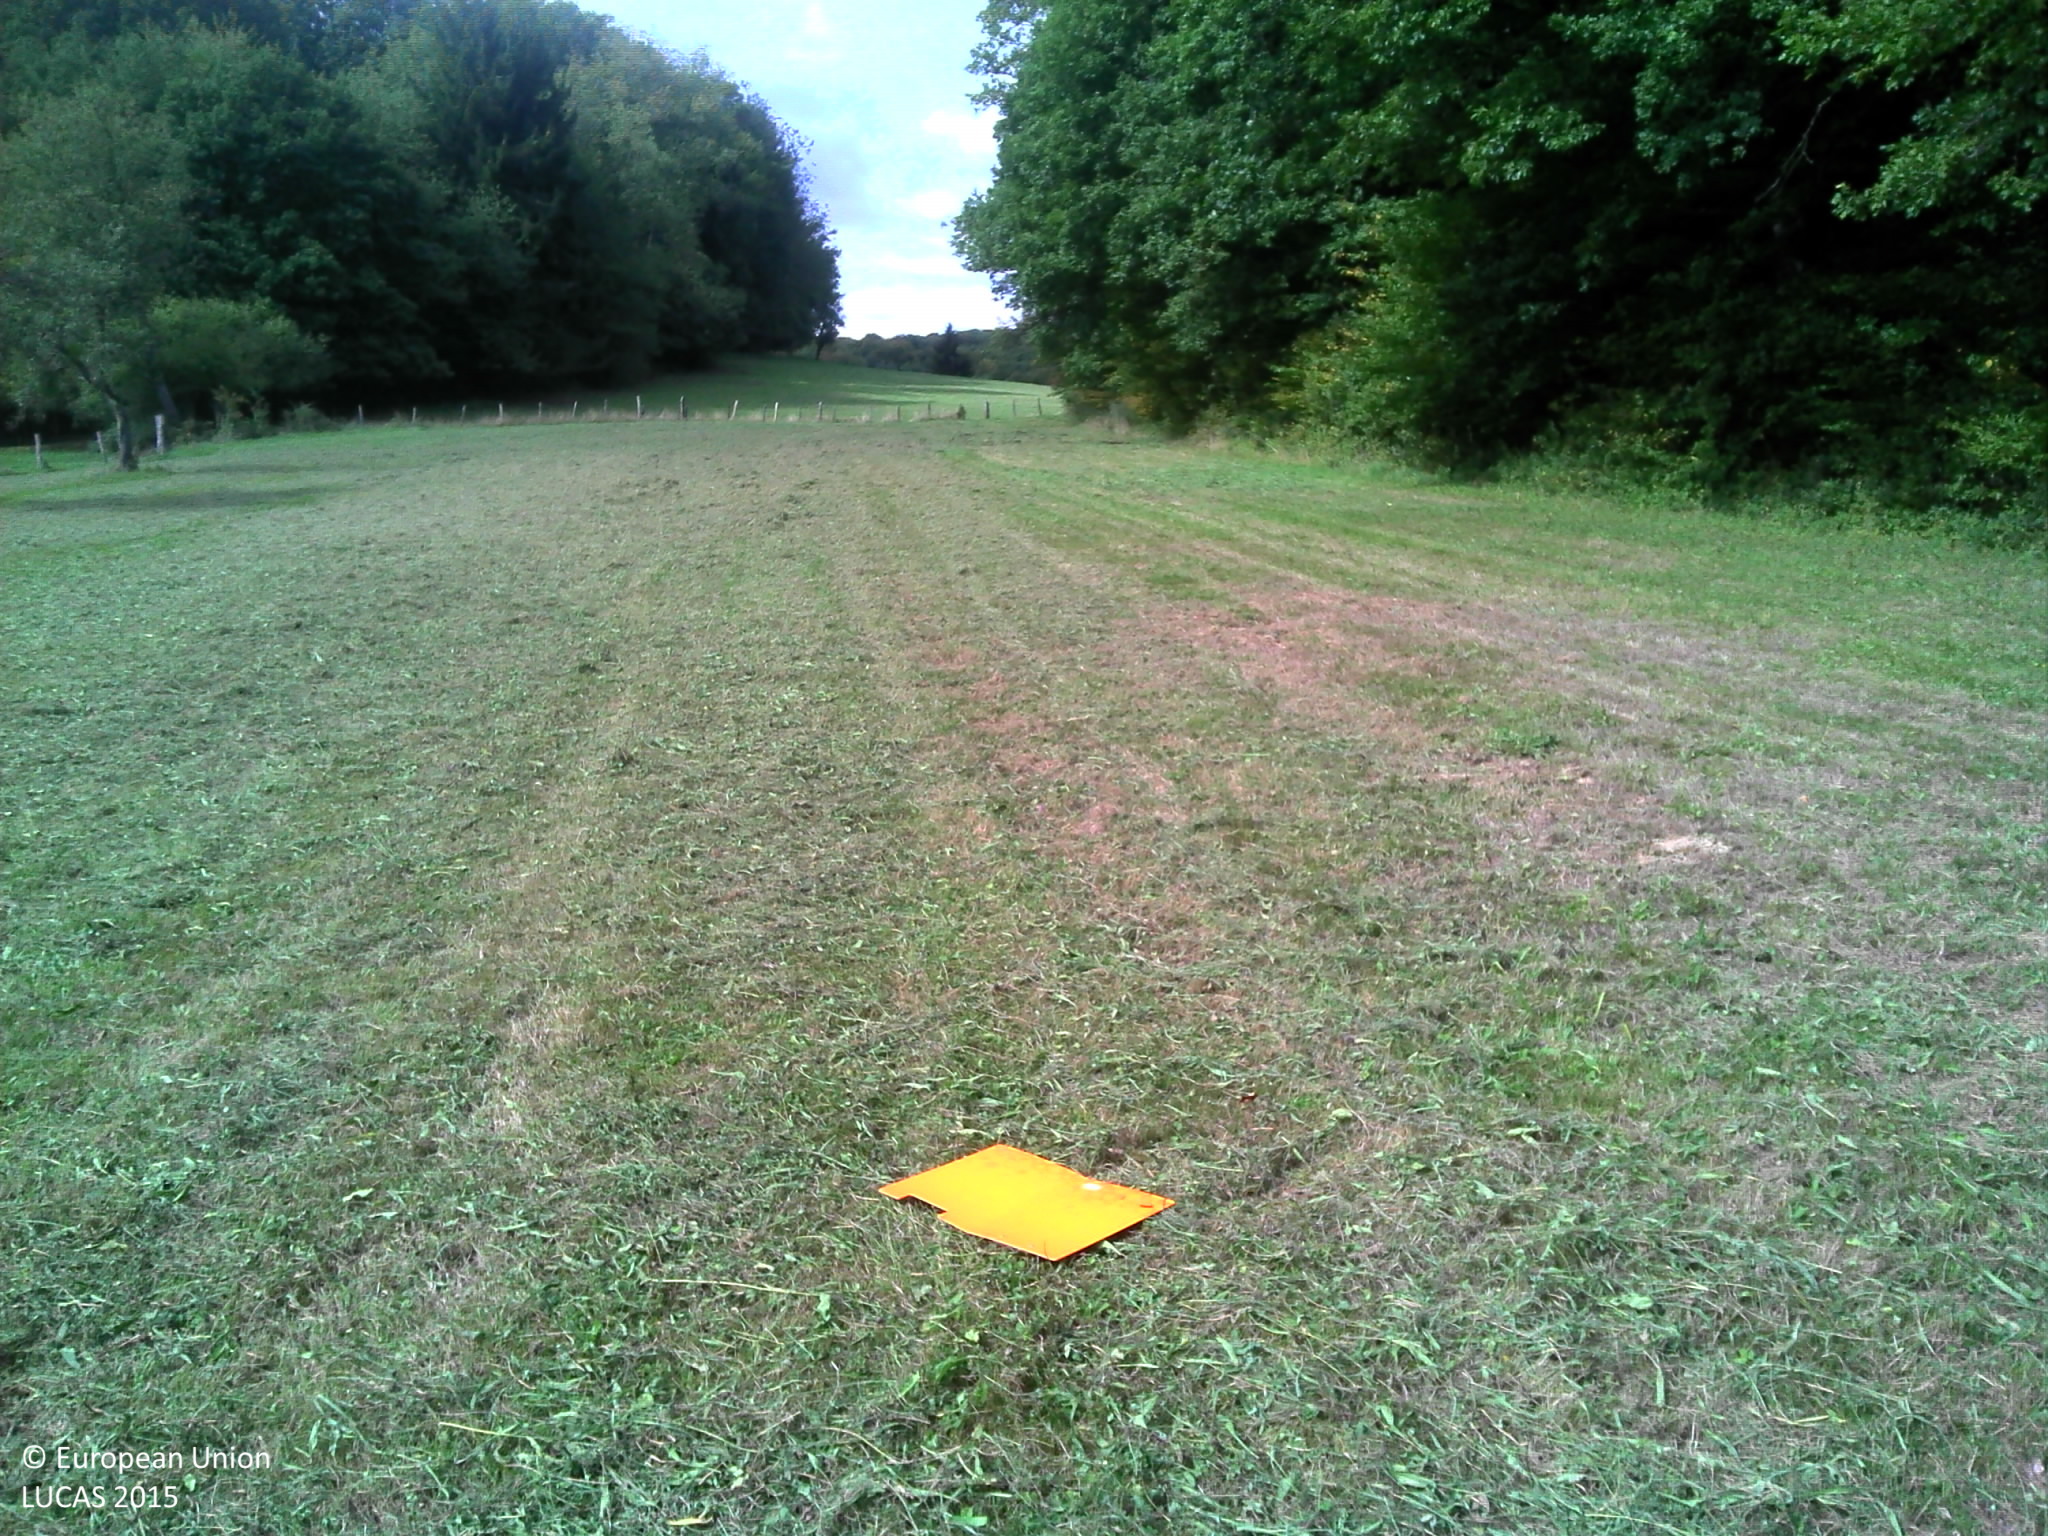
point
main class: Grassland
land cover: Grassland with sparse tree/shrub cover
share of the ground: > 75 %
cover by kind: herbaceous plants 95 %, broadleaved forest trees 5 %
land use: Agriculture (excluding fallow land and kitchen gardens)
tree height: > 5 m
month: September
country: FR
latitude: 47.3455
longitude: 6.1498
